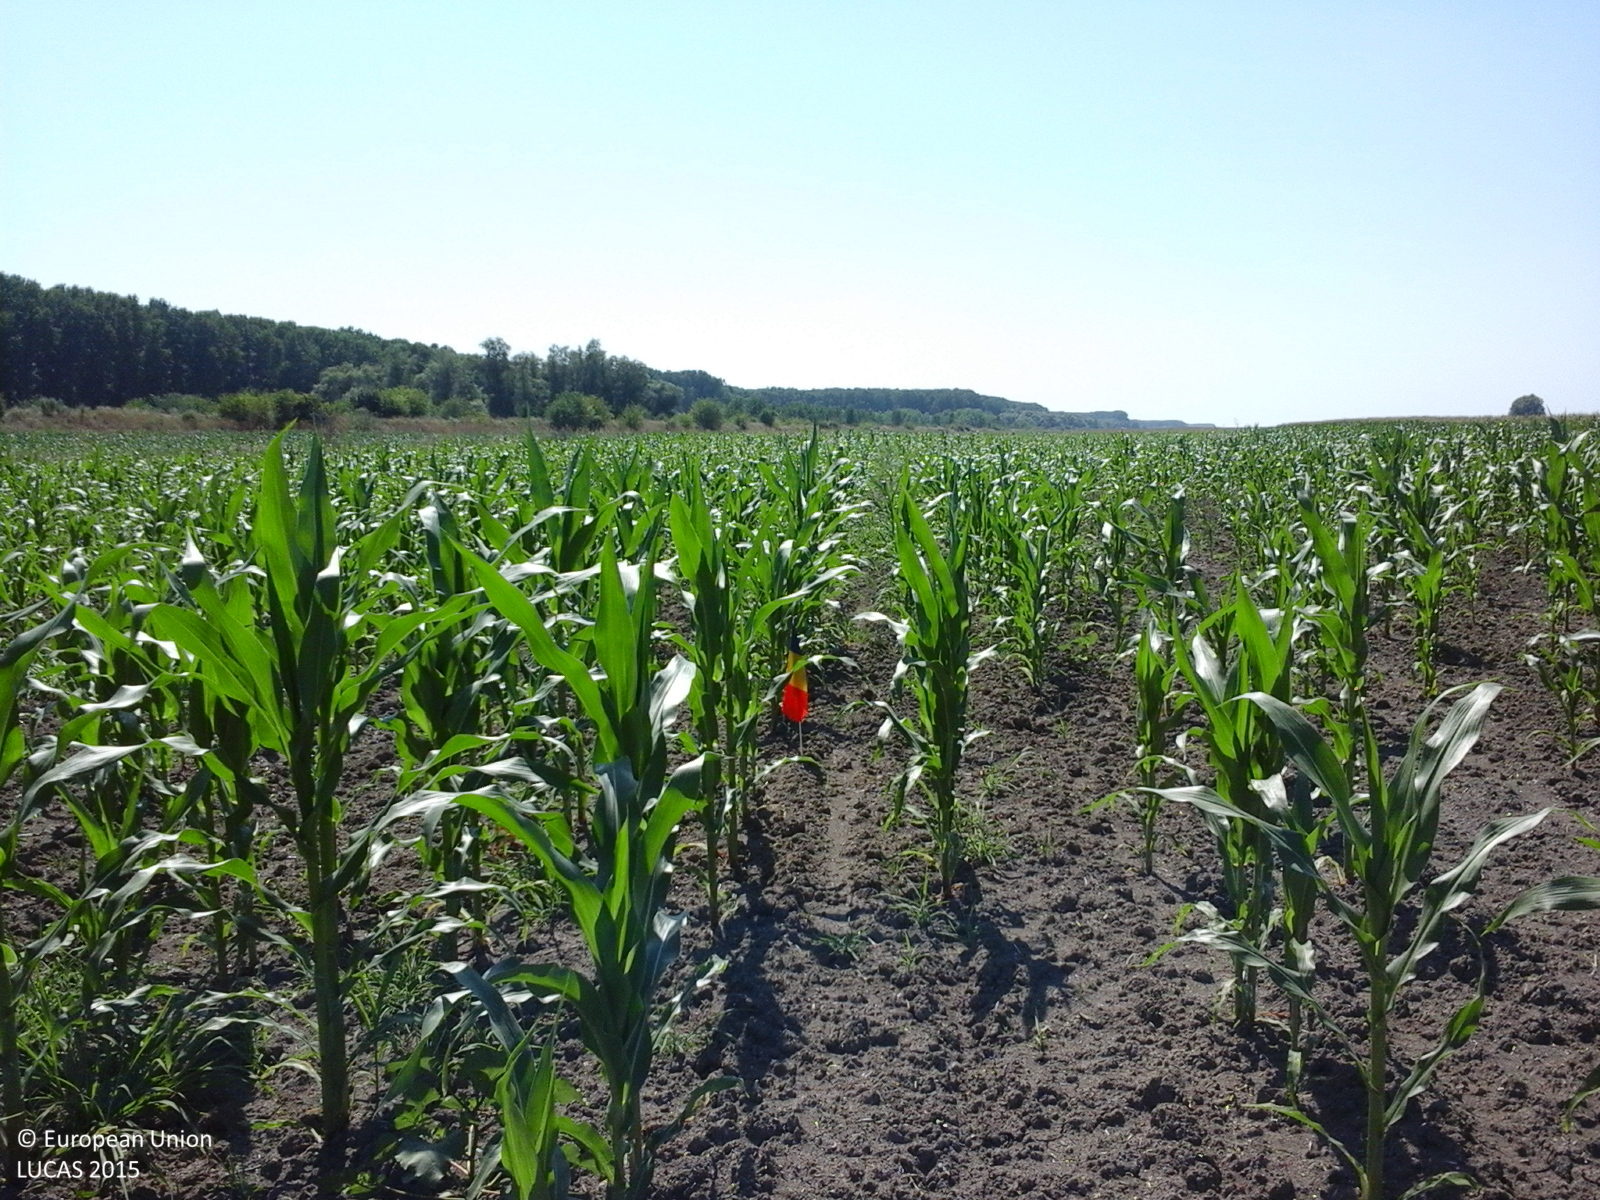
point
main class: Cropland
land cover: Maize
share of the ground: 50 - 75 %
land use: Agriculture (excluding fallow land and kitchen gardens)
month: July
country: RO
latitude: 44.2139
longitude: 27.7055
